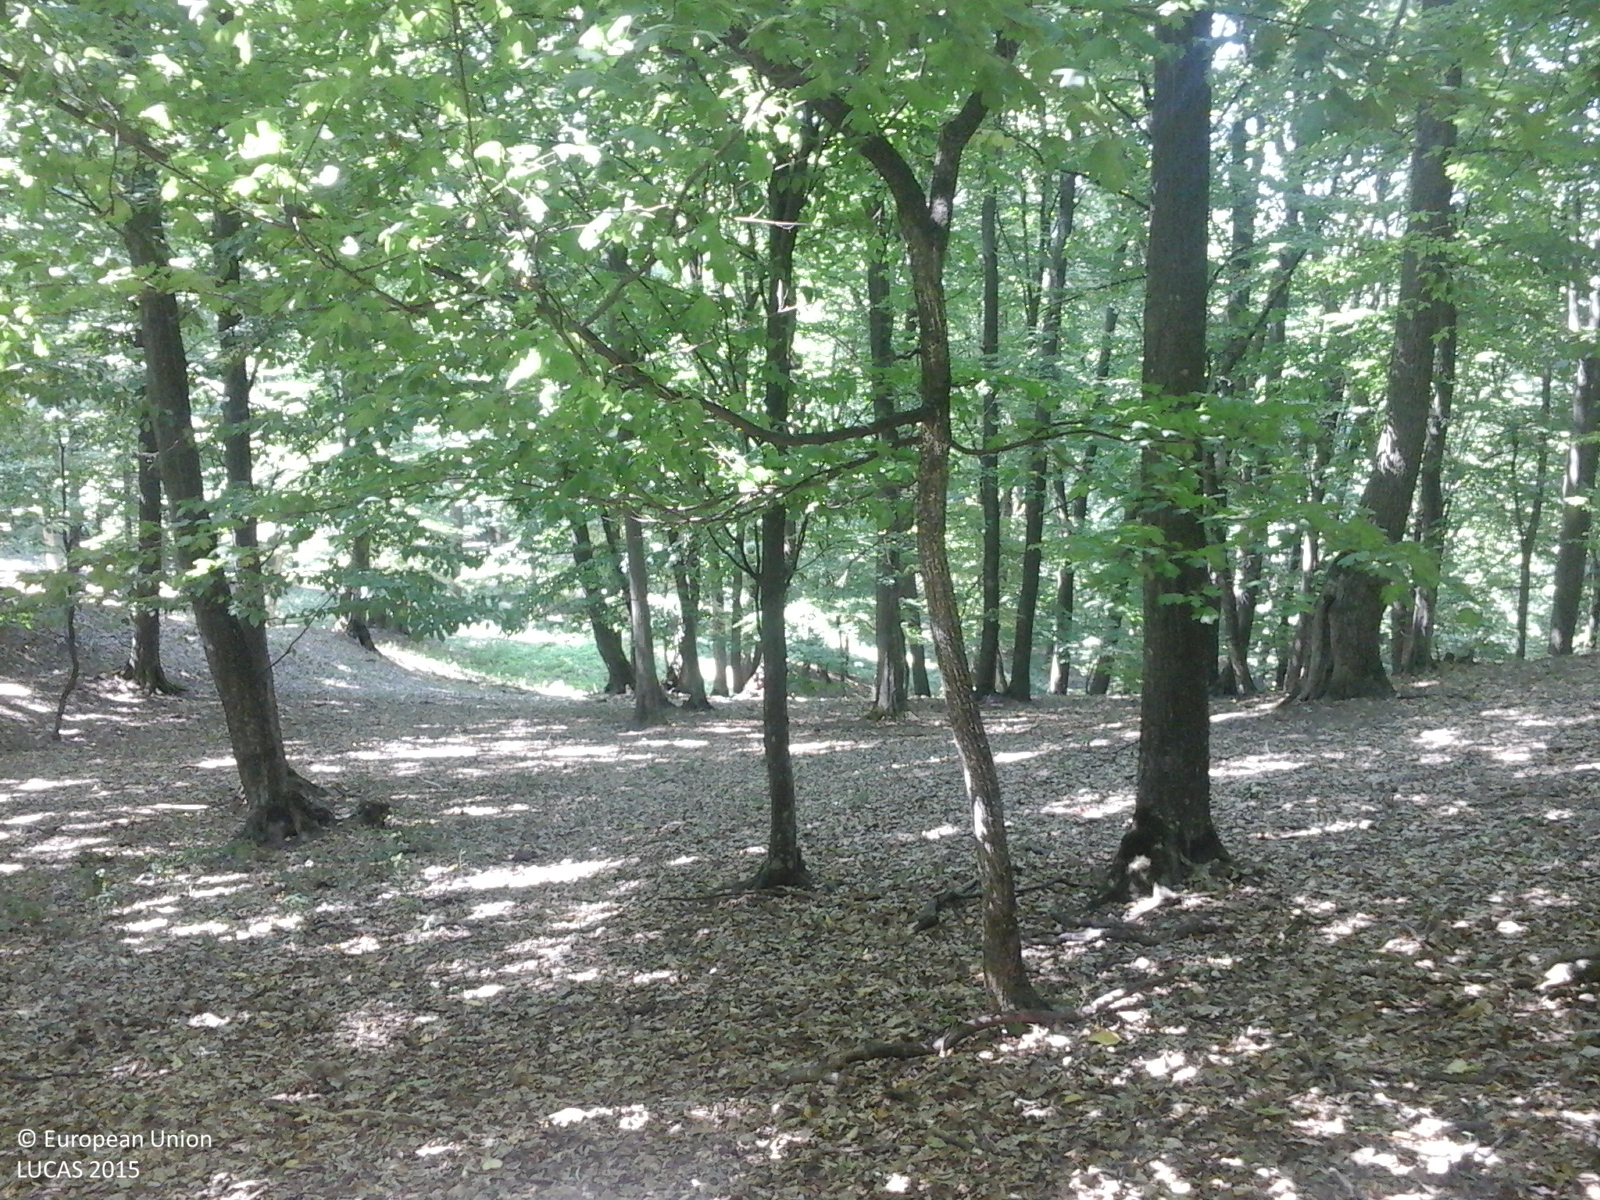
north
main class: Woodland
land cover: Broadleaved woodland
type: beech forest
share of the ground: > 75 %
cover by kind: broadleaved forest trees 100 %
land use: Forestry
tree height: > 5 m
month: June
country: RO
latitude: 46.8485
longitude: 27.0298
